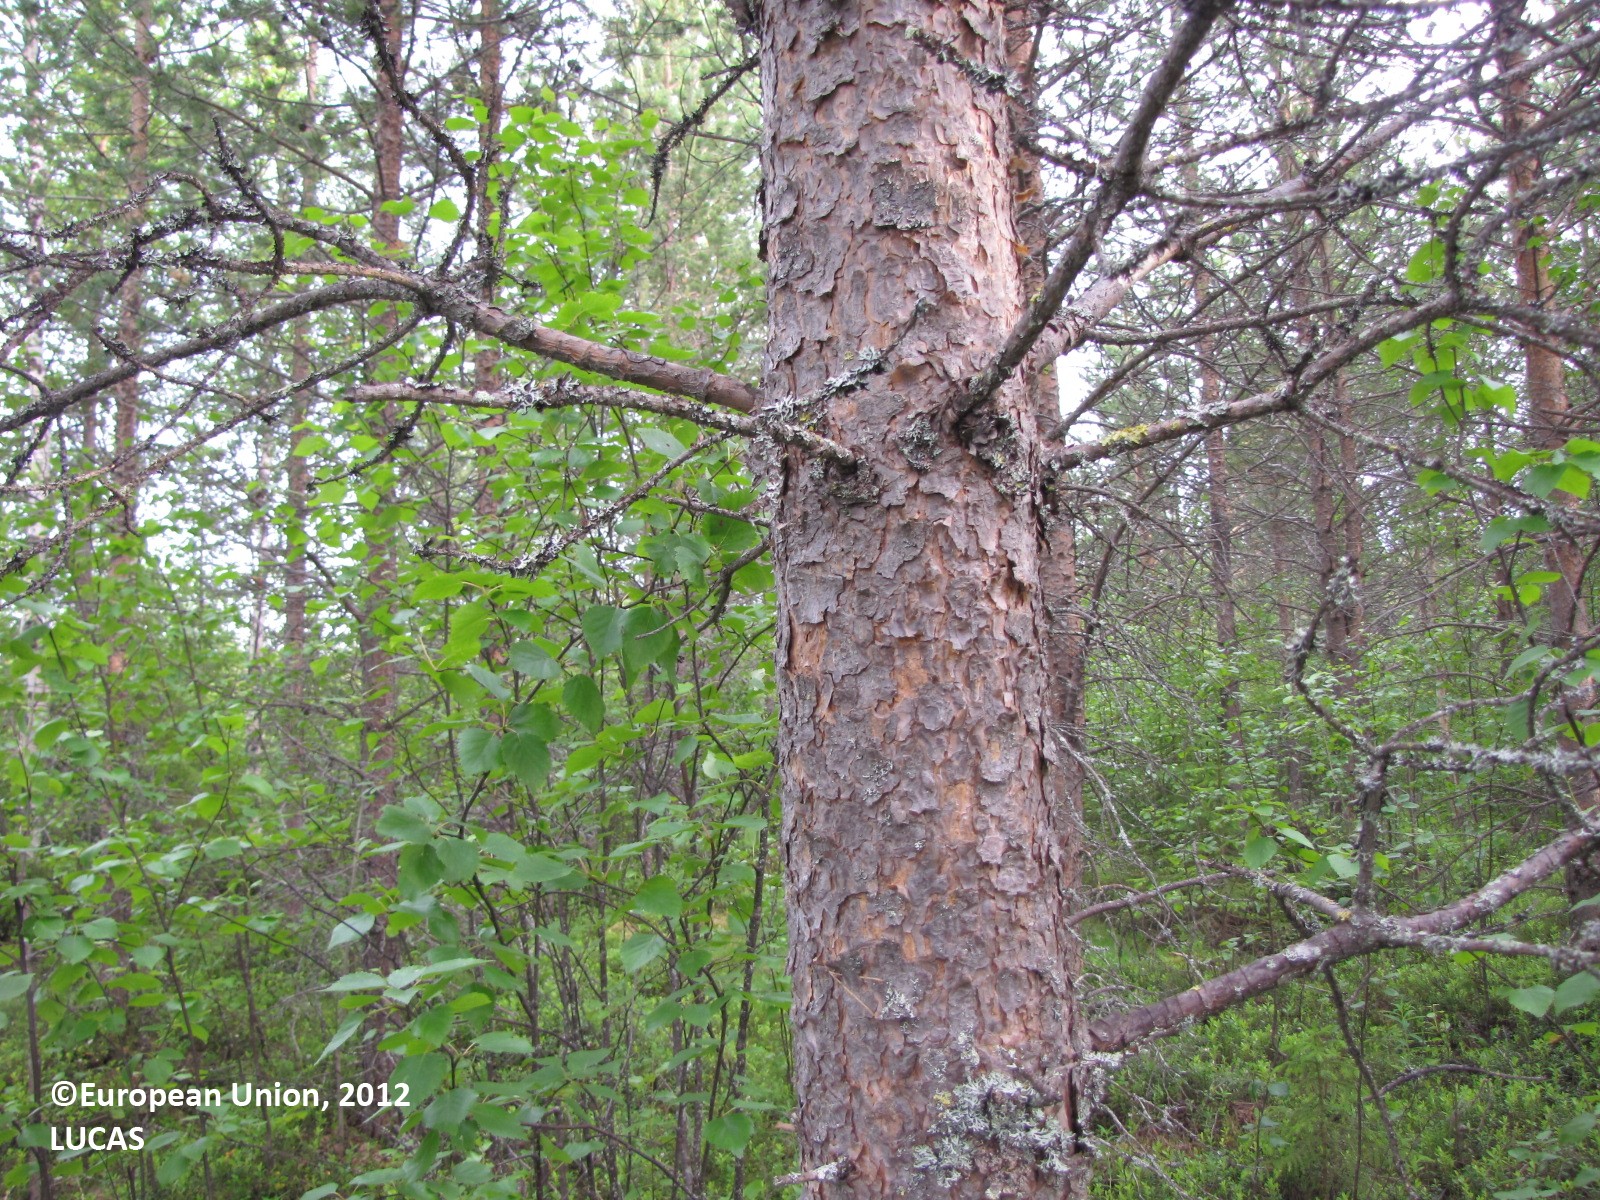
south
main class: Woodland
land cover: Pine dominated mixed woodland
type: boreal forest
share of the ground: 50 - 75 %
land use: Forestry
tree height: > 5 m
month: July
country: FI
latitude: 66.3900
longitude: 25.0705
